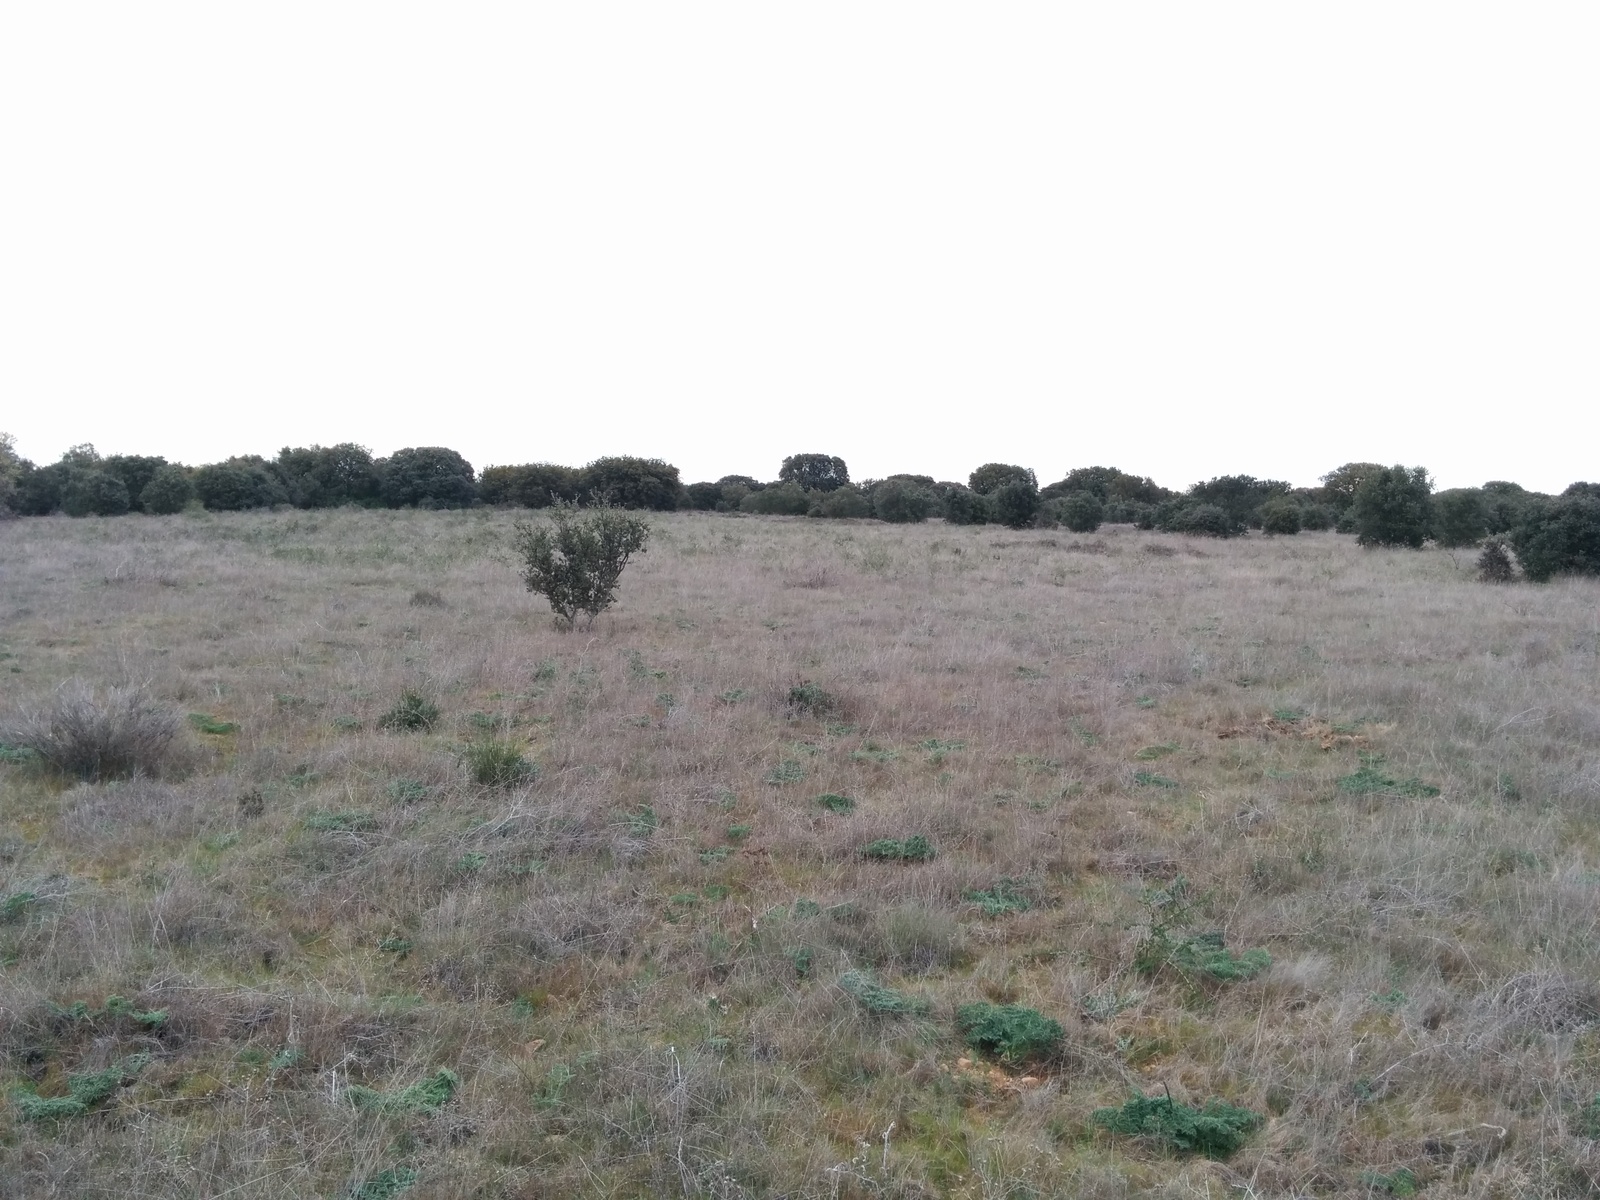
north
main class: Grassland
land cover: Grassland without tree/shrub cover
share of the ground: > 75 %
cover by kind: herbaceous plants 100 %
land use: Abandoned areas
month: April
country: ES
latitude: 42.4532
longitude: -5.6738
